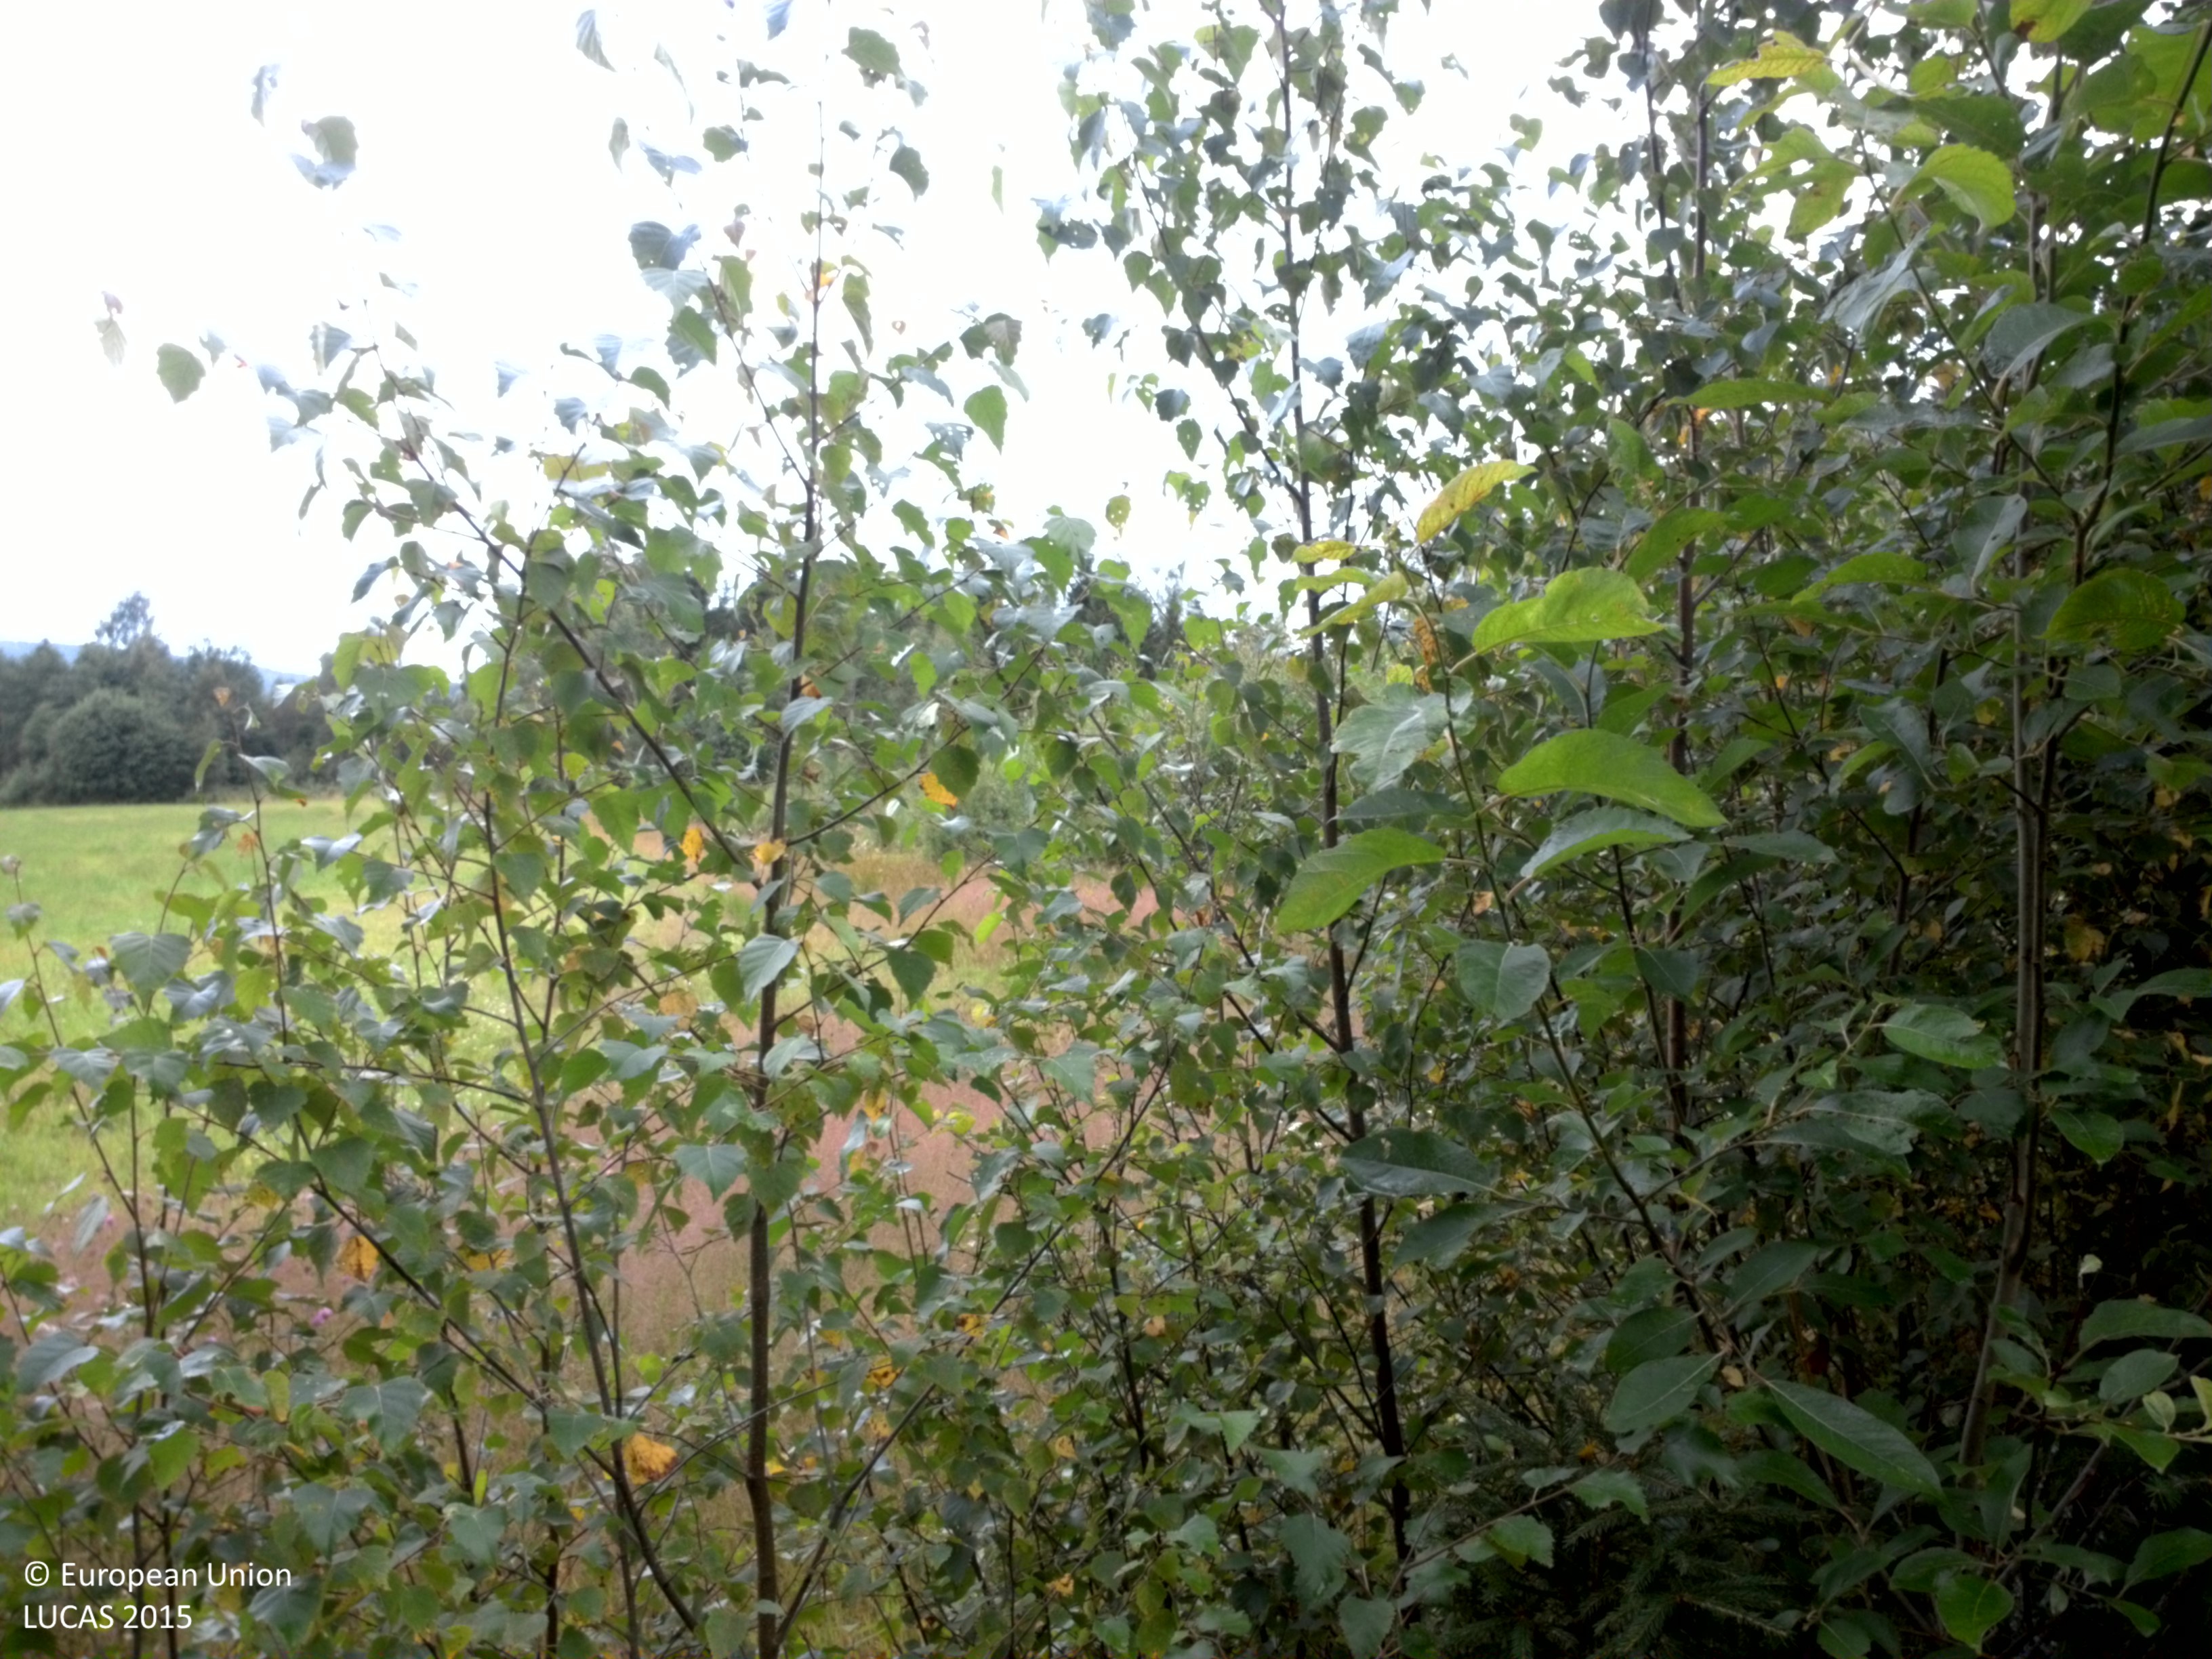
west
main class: Artificial land
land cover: Other artificial areas
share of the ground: 50 - 75 %
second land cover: Shrubland with sparse tree cover
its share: 50 - 75 %
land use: Electricity, gas and thermal power distribution
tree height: < 5 m
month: August
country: SE
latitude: 59.5843
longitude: 13.2681
